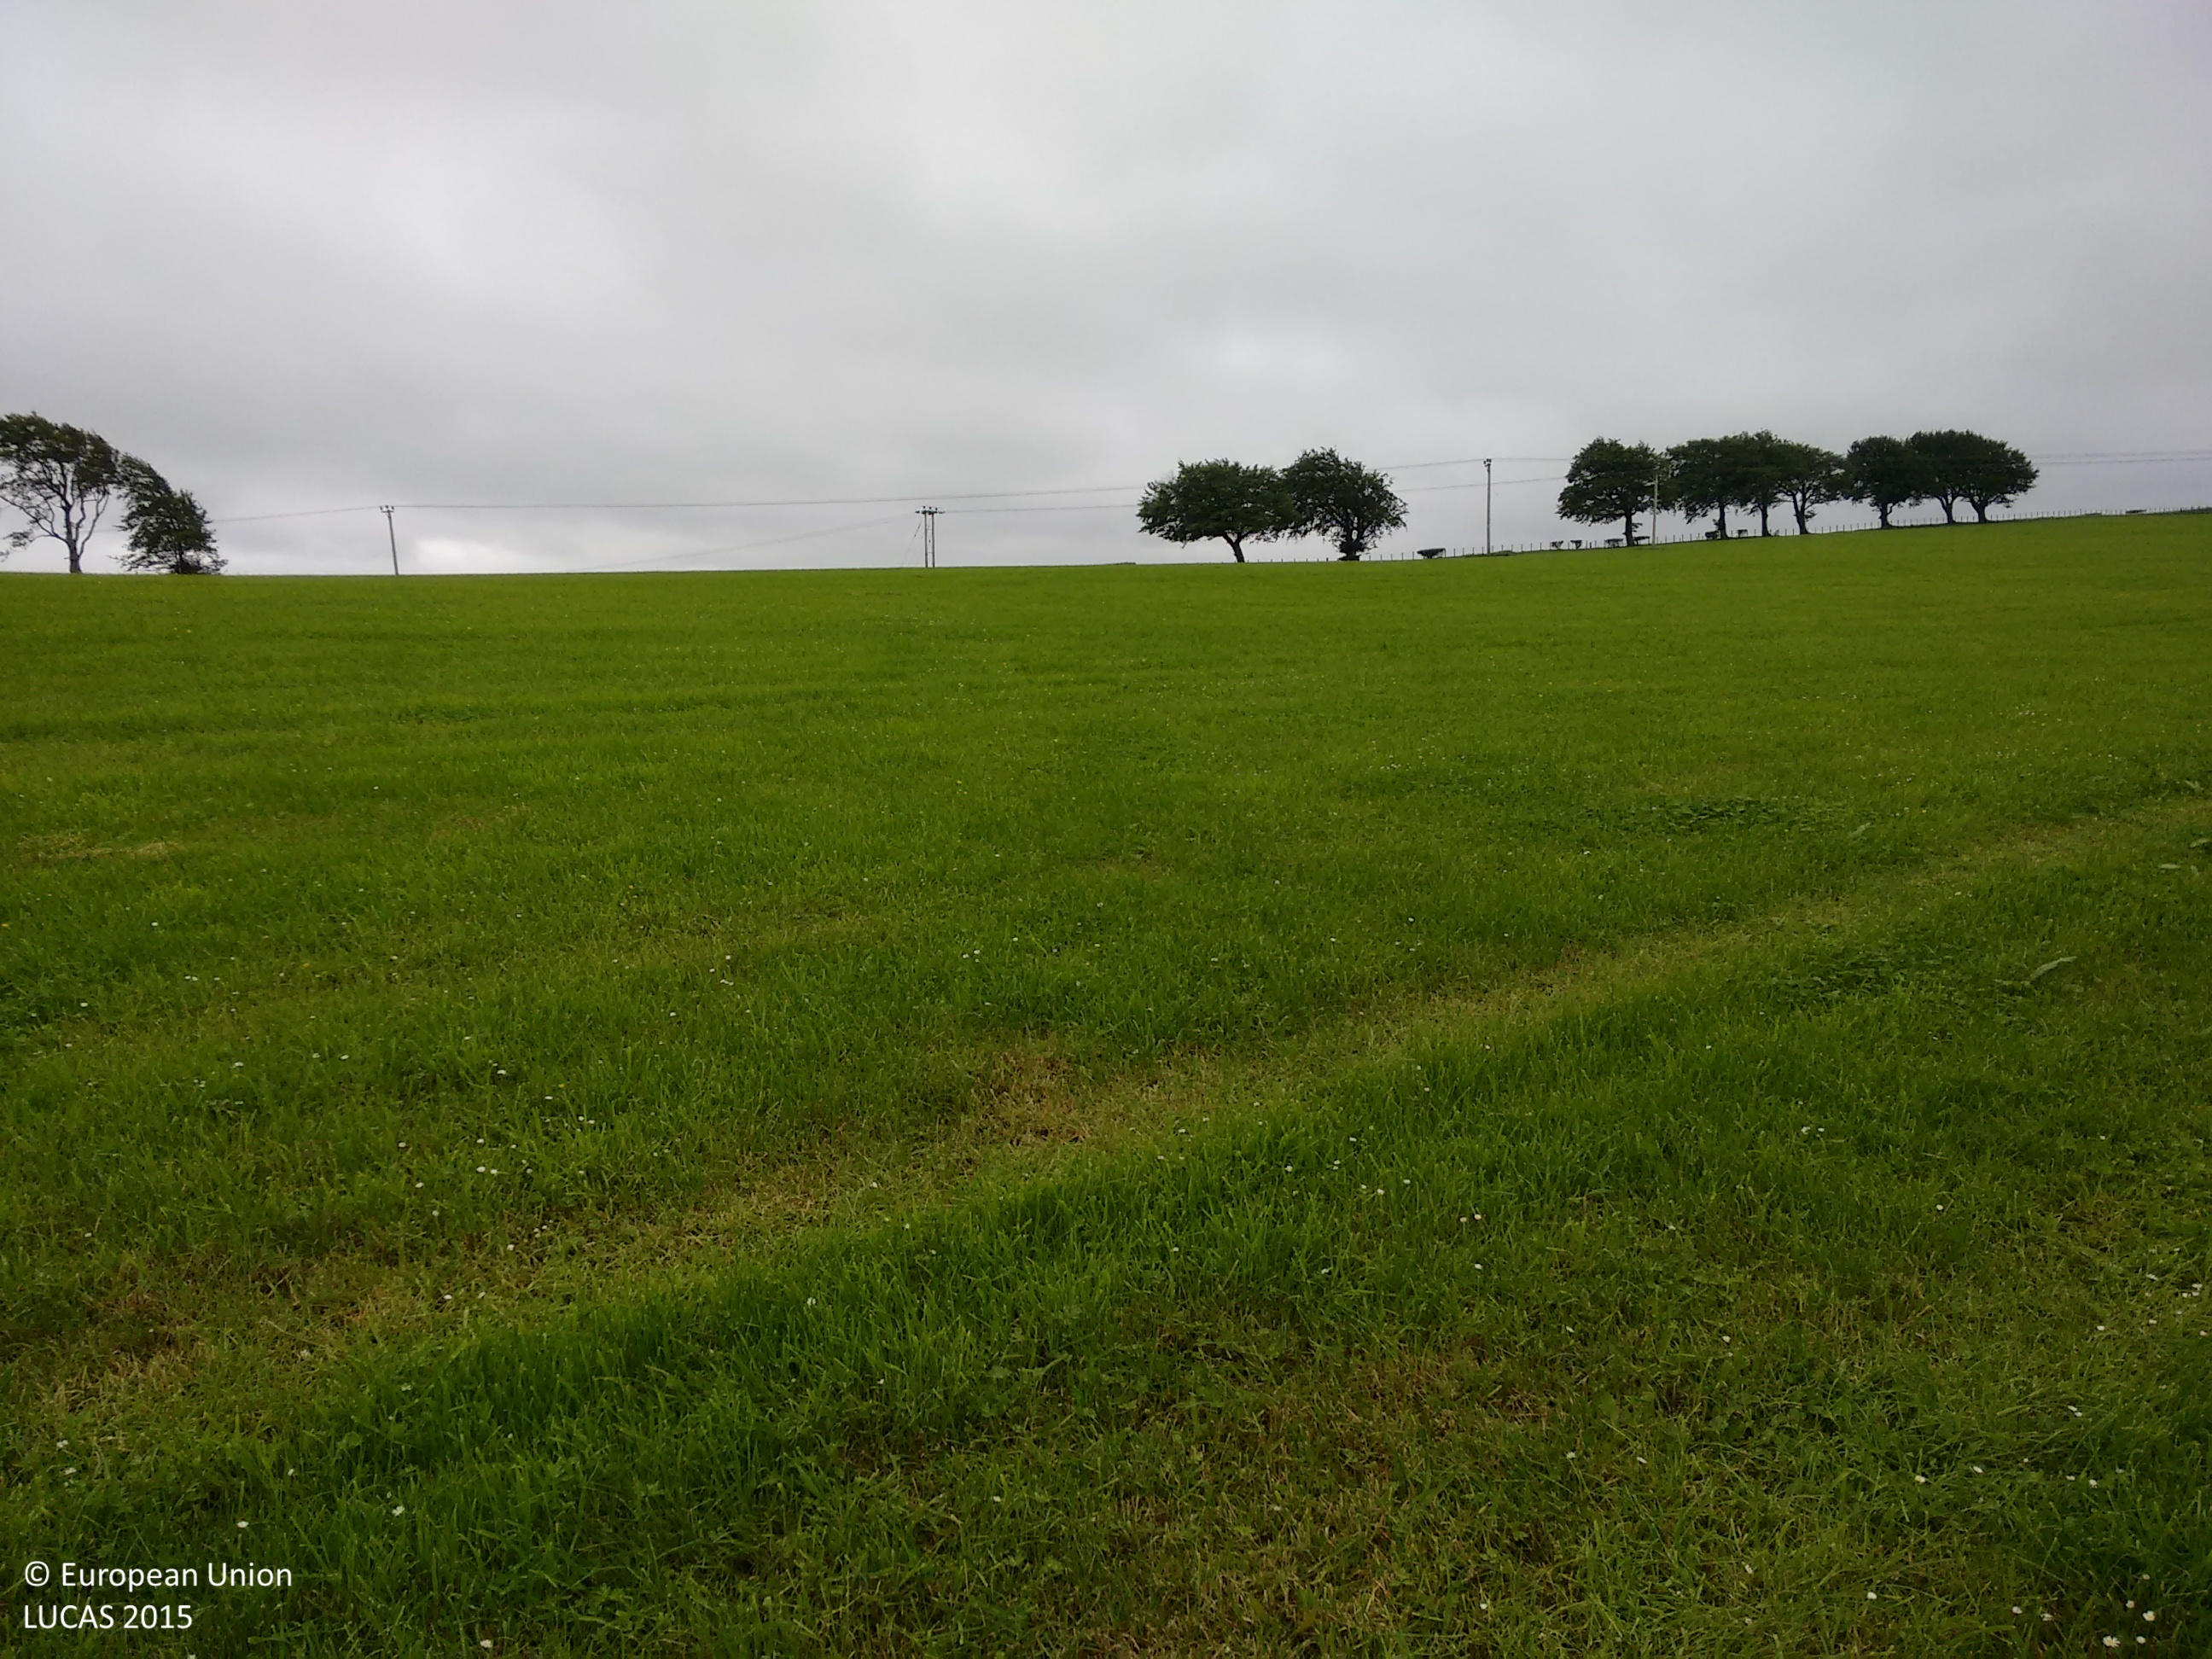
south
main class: Grassland
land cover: Grassland without tree/shrub cover
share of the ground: > 75 %
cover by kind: herbaceous plants 100 %
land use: Agriculture (excluding fallow land and kitchen gardens)
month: June
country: GB
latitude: 55.6529
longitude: -3.8321
